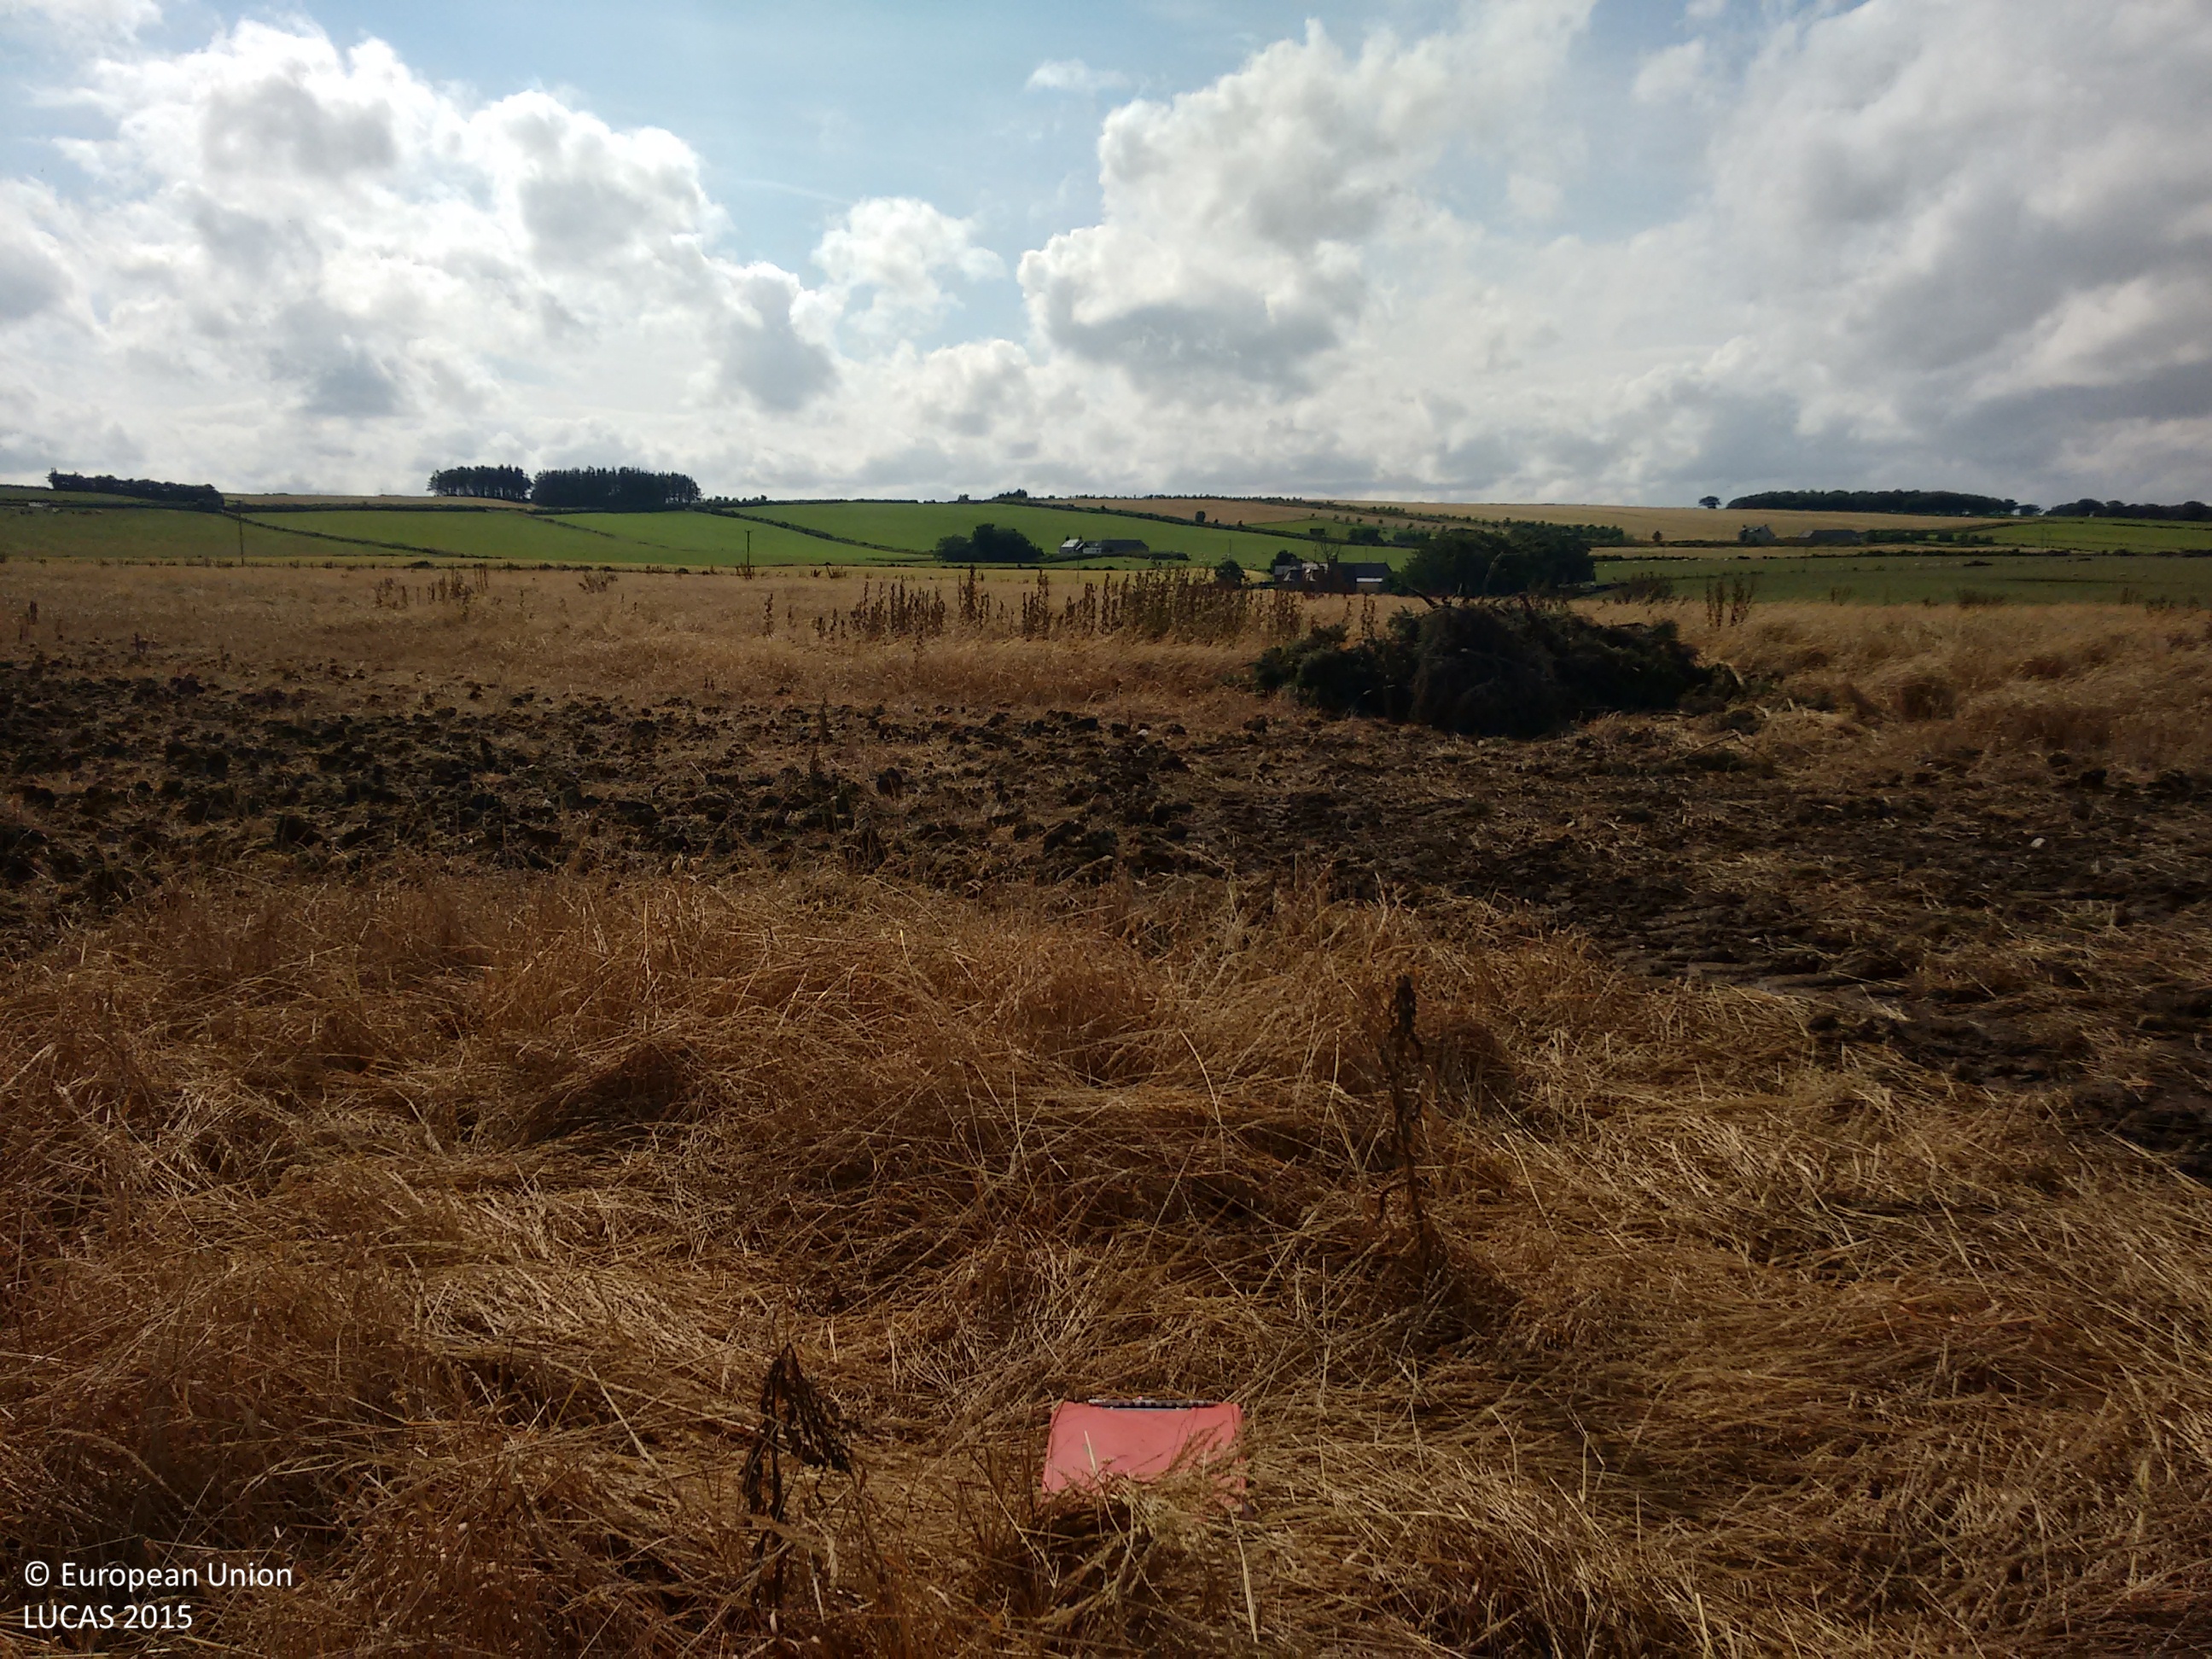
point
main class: Grassland
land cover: Grassland without tree/shrub cover
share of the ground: 50 - 75 %
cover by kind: herbaceous plants 75 %, unconsolidated bare surface 25 %
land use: Agriculture (excluding fallow land and kitchen gardens)
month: August
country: GB
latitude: 57.5491
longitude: -2.2296
